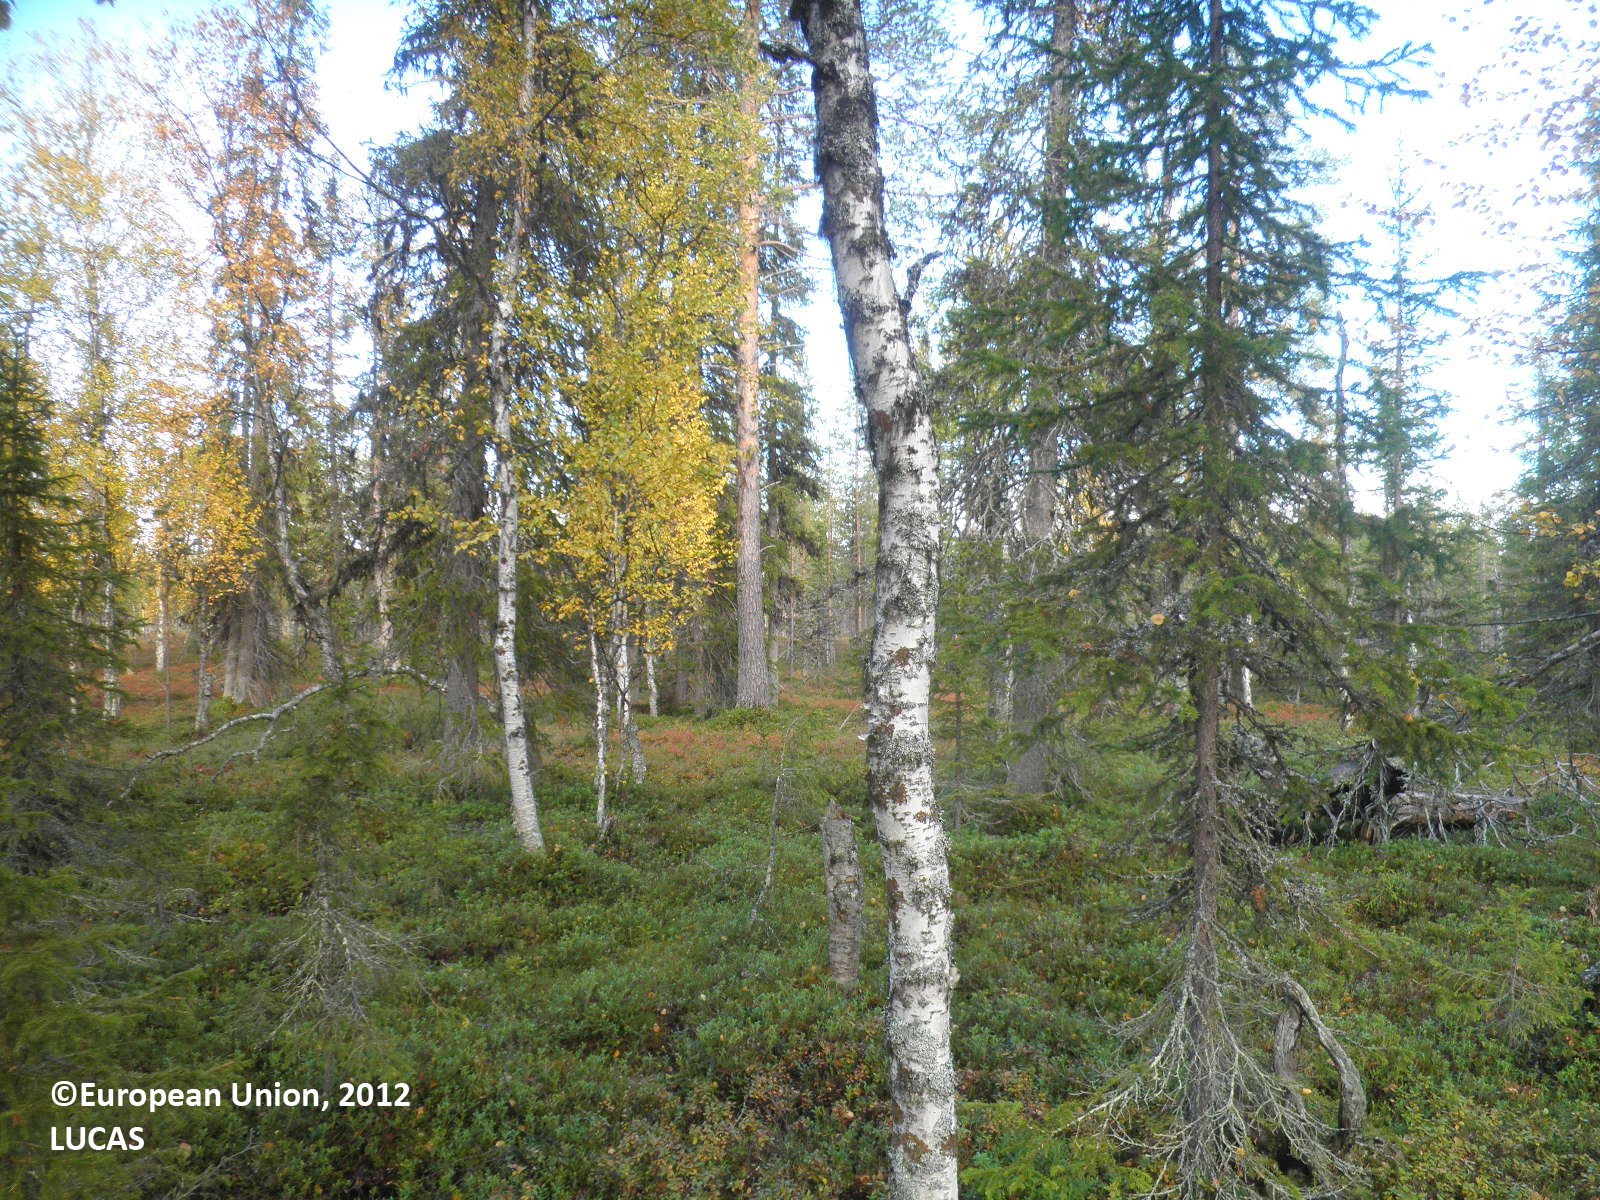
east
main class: Woodland
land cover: Spruce dominated mixed woodland
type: boreal forest
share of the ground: 25 - 50 %
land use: Forestry
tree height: > 5 m
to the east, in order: Spruce dominated mixed woodland; Pine dominated coniferous woodland; Pine dominated mixed woodland
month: September
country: FI
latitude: 67.7646
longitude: 28.7202
